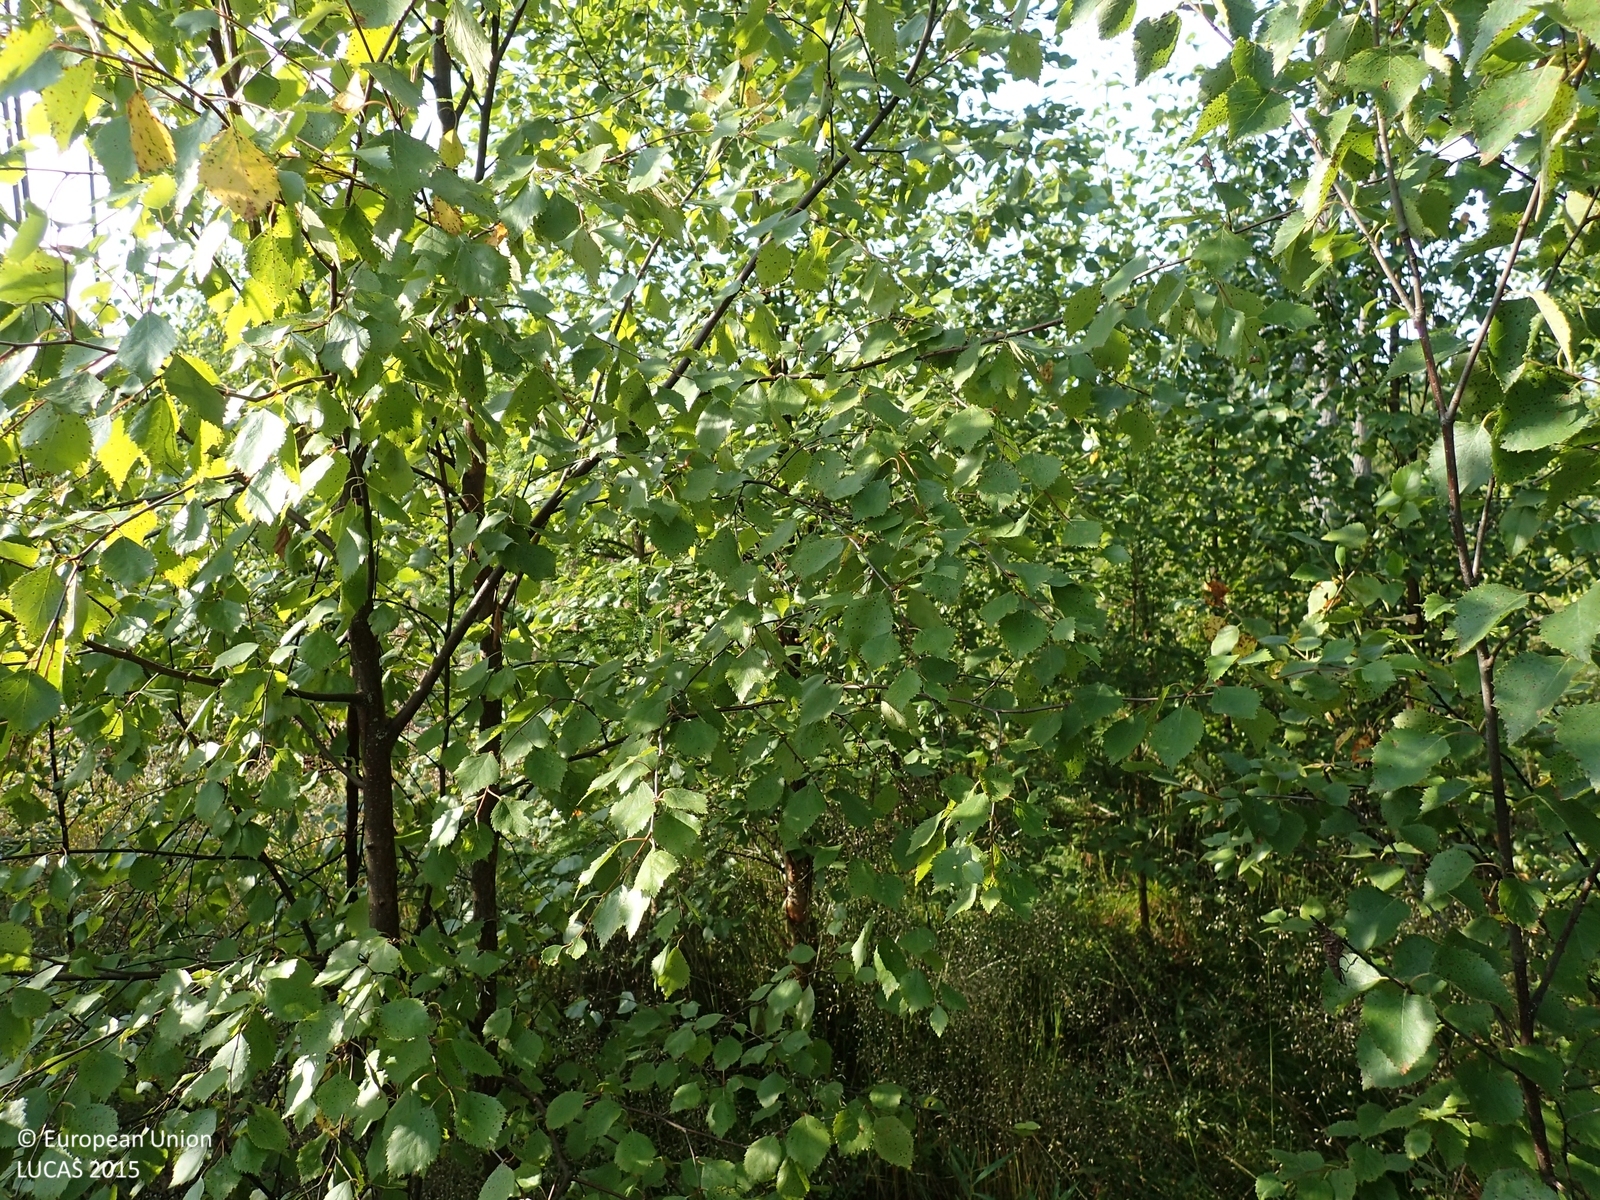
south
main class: Woodland
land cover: Other mixed woodland
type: boreal forest
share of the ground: > 75 %
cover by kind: broadleaved forest trees 55 %, coniferous forest trees 20 %, herbaceous plants 15 %, shrubs 10 %
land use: Forestry
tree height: < 5 m
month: August
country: FI
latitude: 62.6212
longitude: 22.0360
